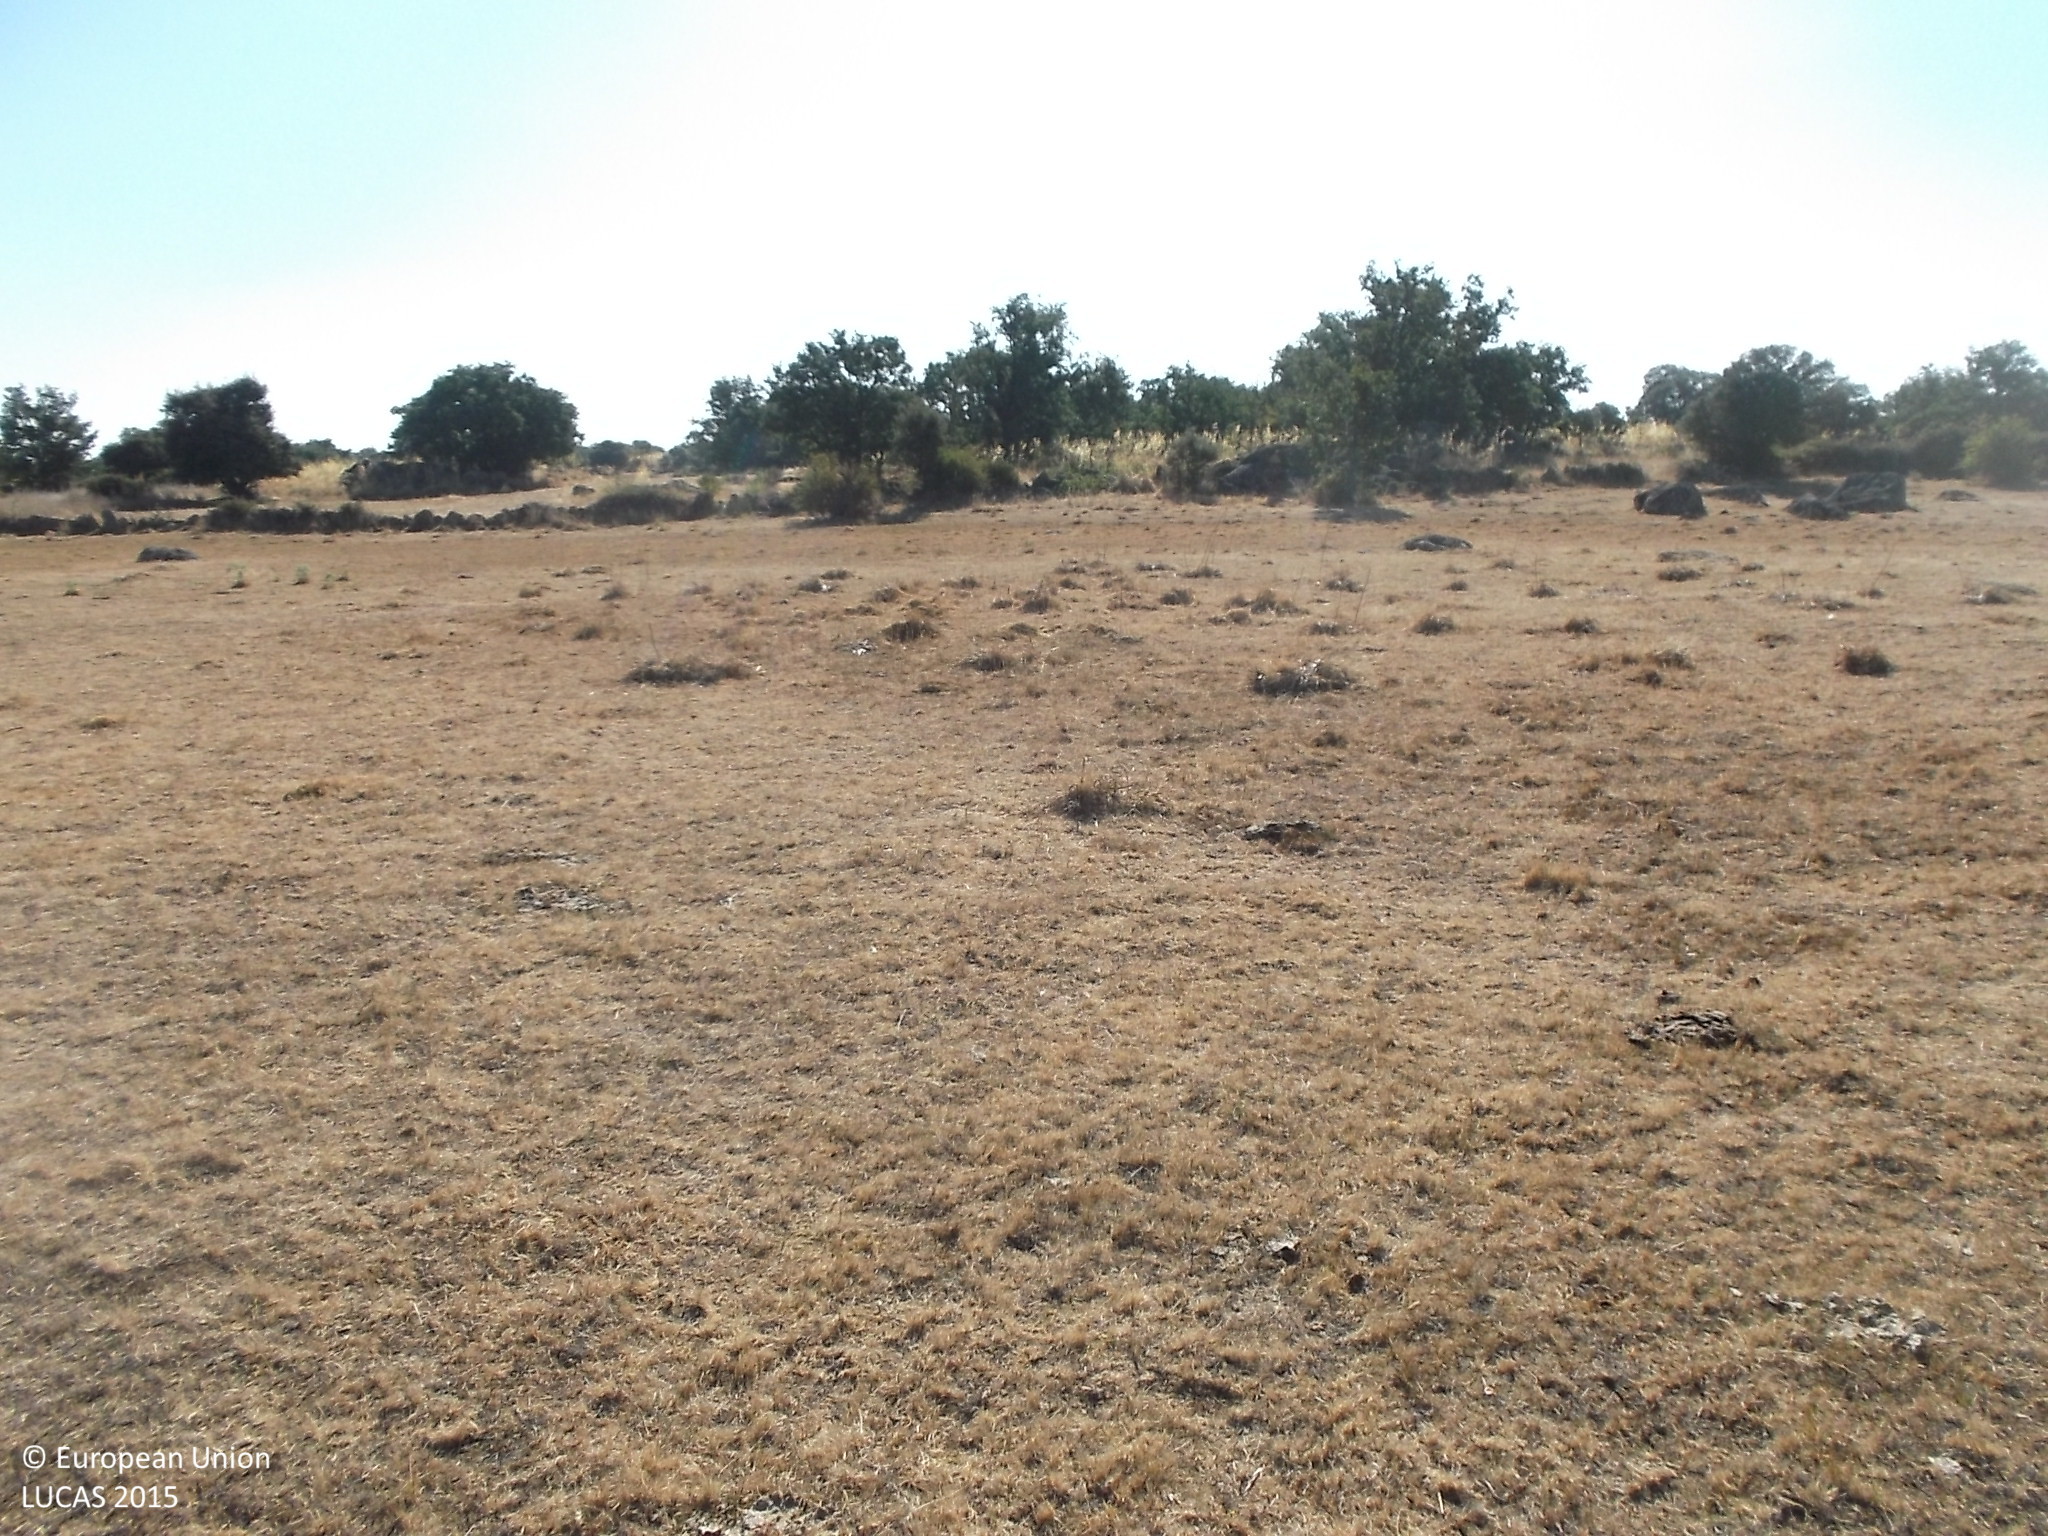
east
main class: Grassland
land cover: Grassland without tree/shrub cover
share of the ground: > 75 %
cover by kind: herbaceous plants 100 %
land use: Agriculture (excluding fallow land and kitchen gardens)
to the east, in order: Grassland without tree/shrub cover; Dry stone walls; Rocks and stones; Broadleaved woodland; Grassland without tree/shrub cover; Dry stone walls; Grass margins; Tracks; Grassland without tree/shrub cover
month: July
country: ES
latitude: 41.3329
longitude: -6.0175
